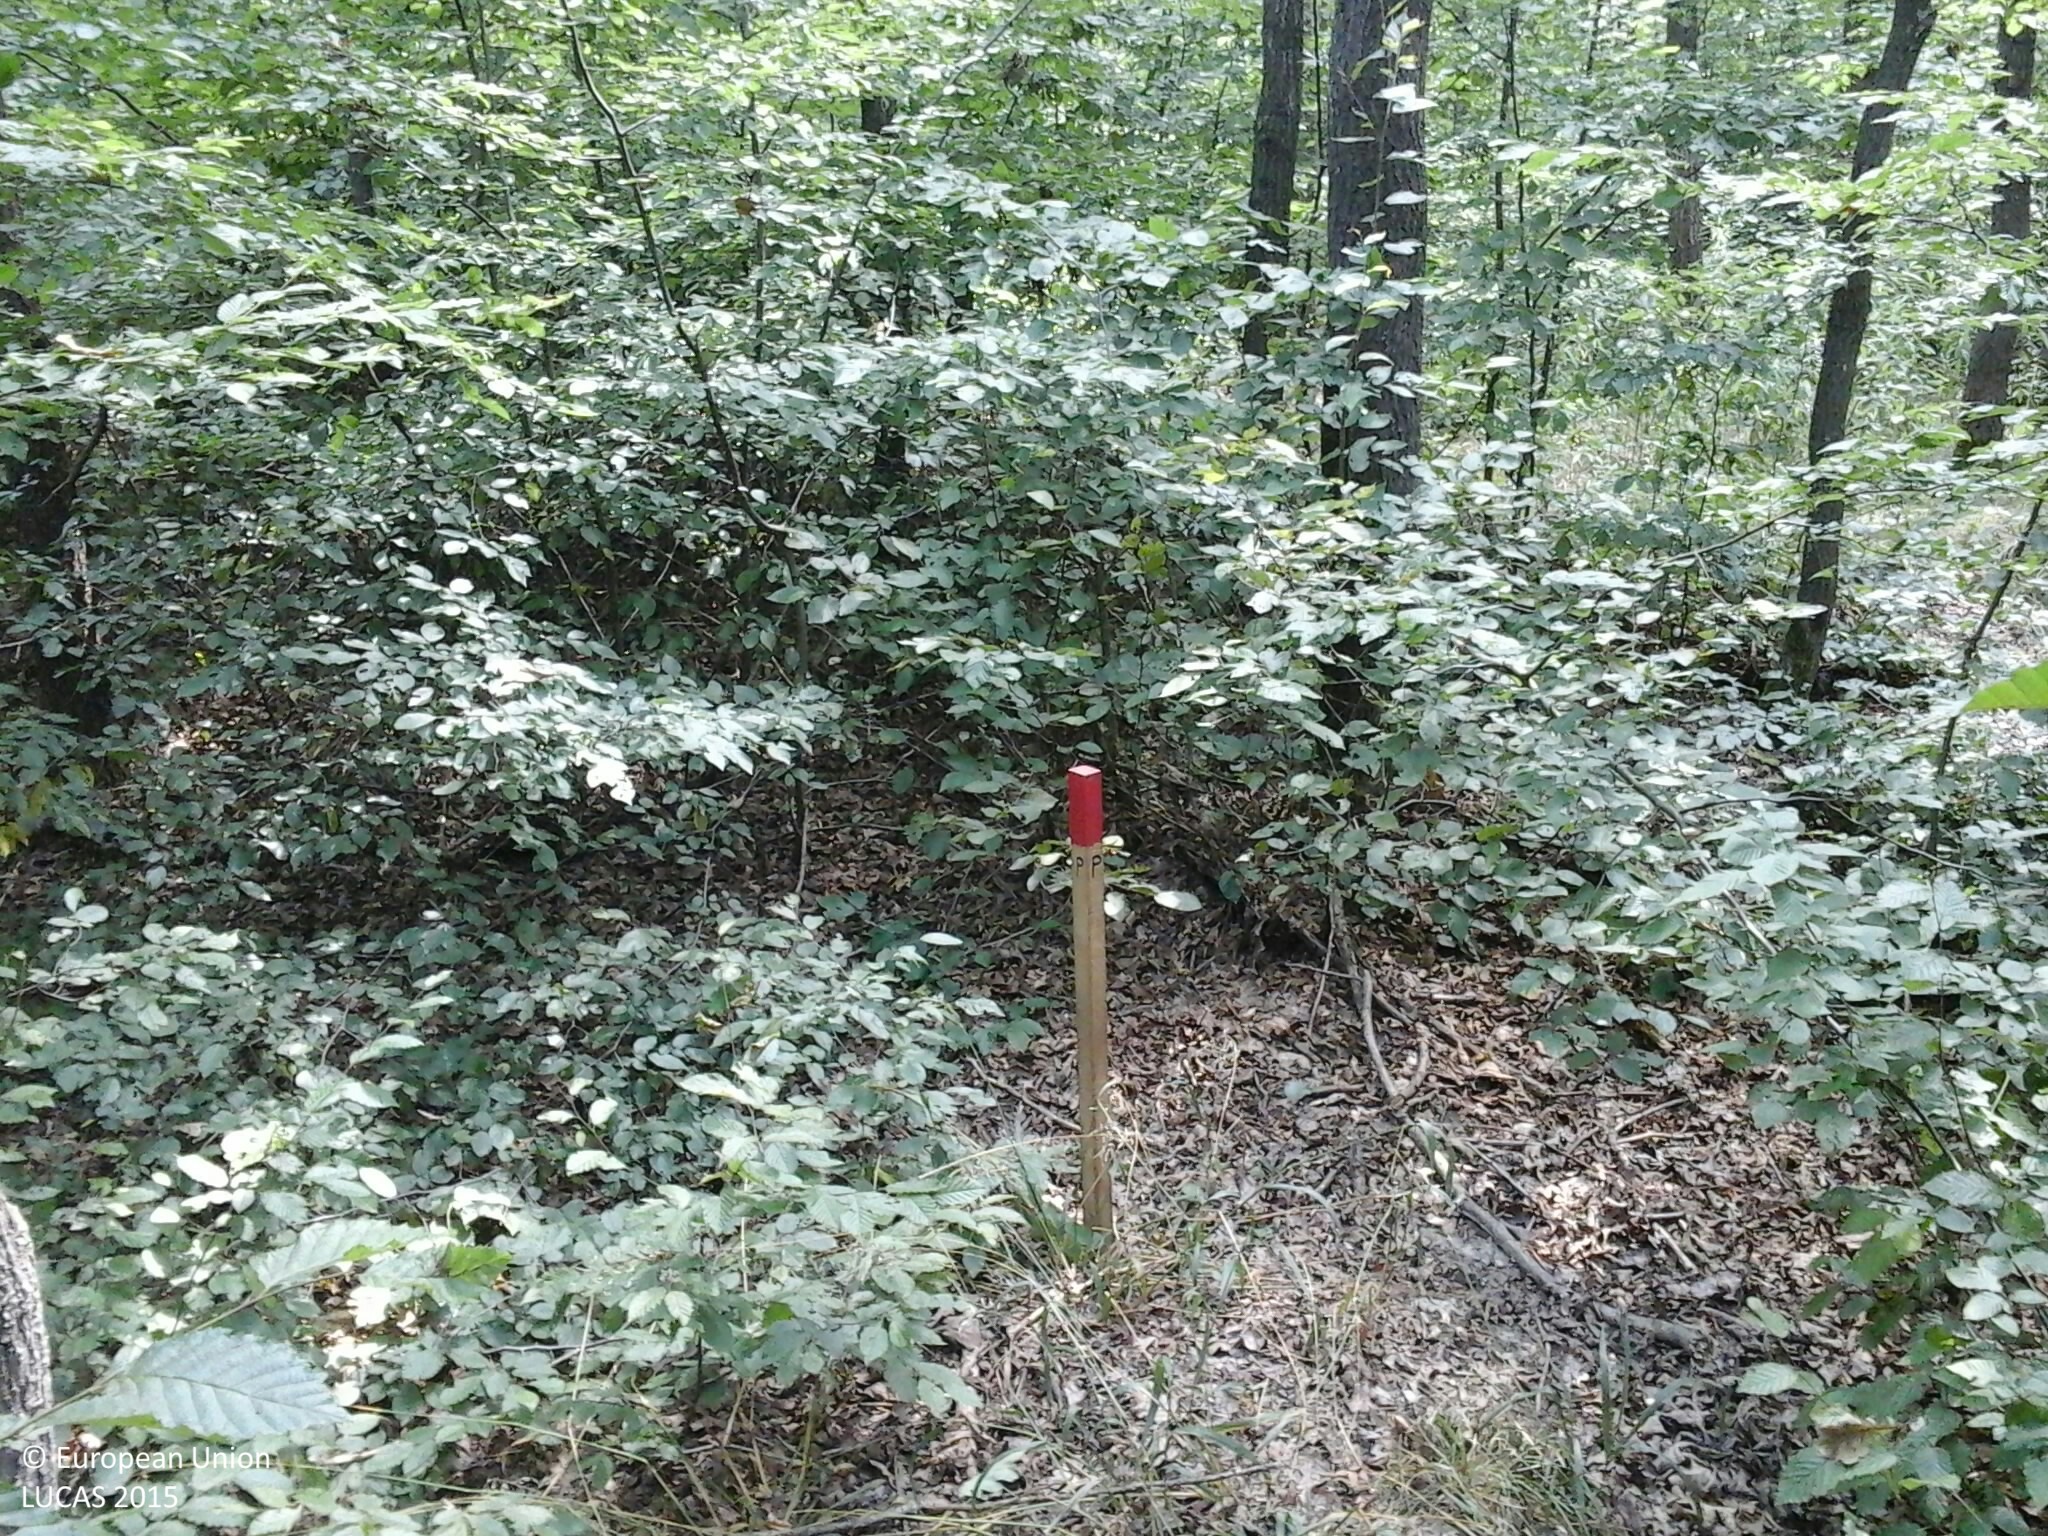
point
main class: Woodland
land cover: Broadleaved woodland
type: beech forest
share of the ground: > 75 %
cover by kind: broadleaved forest trees 75 %, coniferous forest trees 10 %, shrubs 10 %, herbaceous plants 5 %
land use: Forestry
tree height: > 5 m
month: July
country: HU
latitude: 46.9611
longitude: 16.5866
